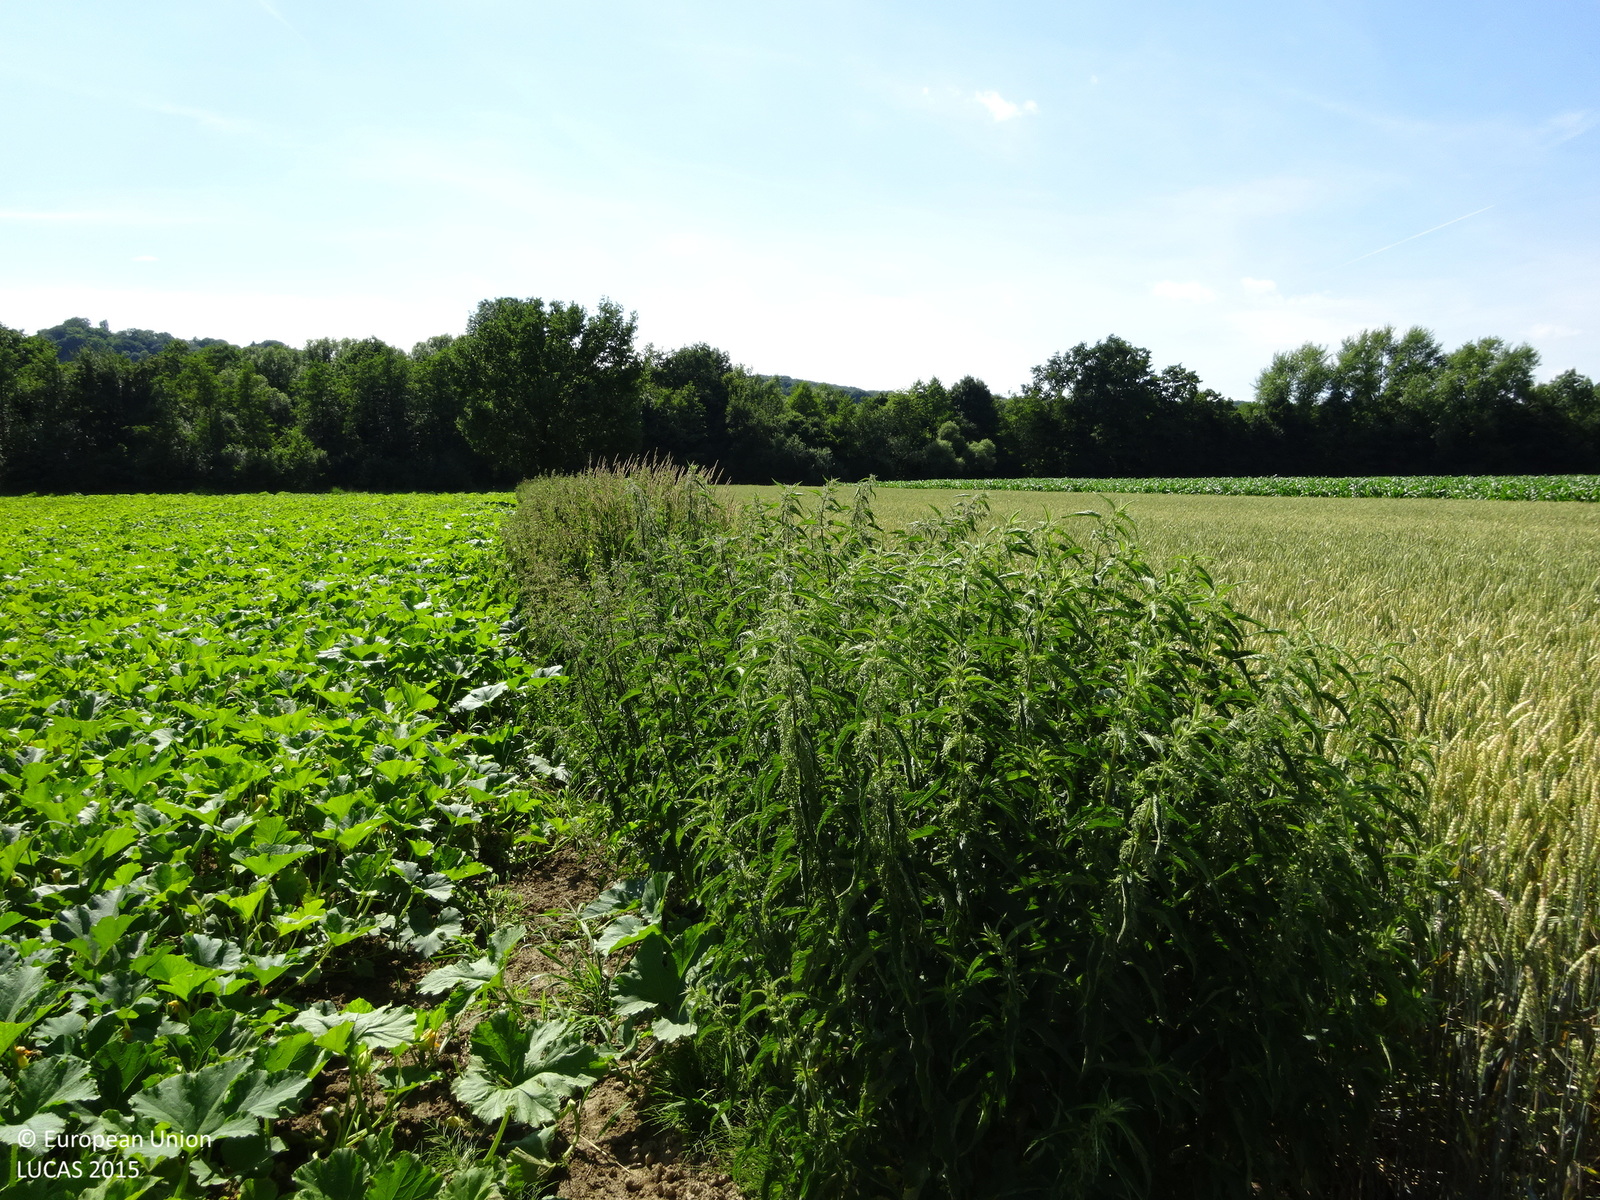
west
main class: Cropland
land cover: Other fibre and oleaginous crops
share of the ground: > 75 %
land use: Agriculture (excluding fallow land and kitchen gardens)
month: June
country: AT
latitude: 46.7880
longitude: 15.8293
